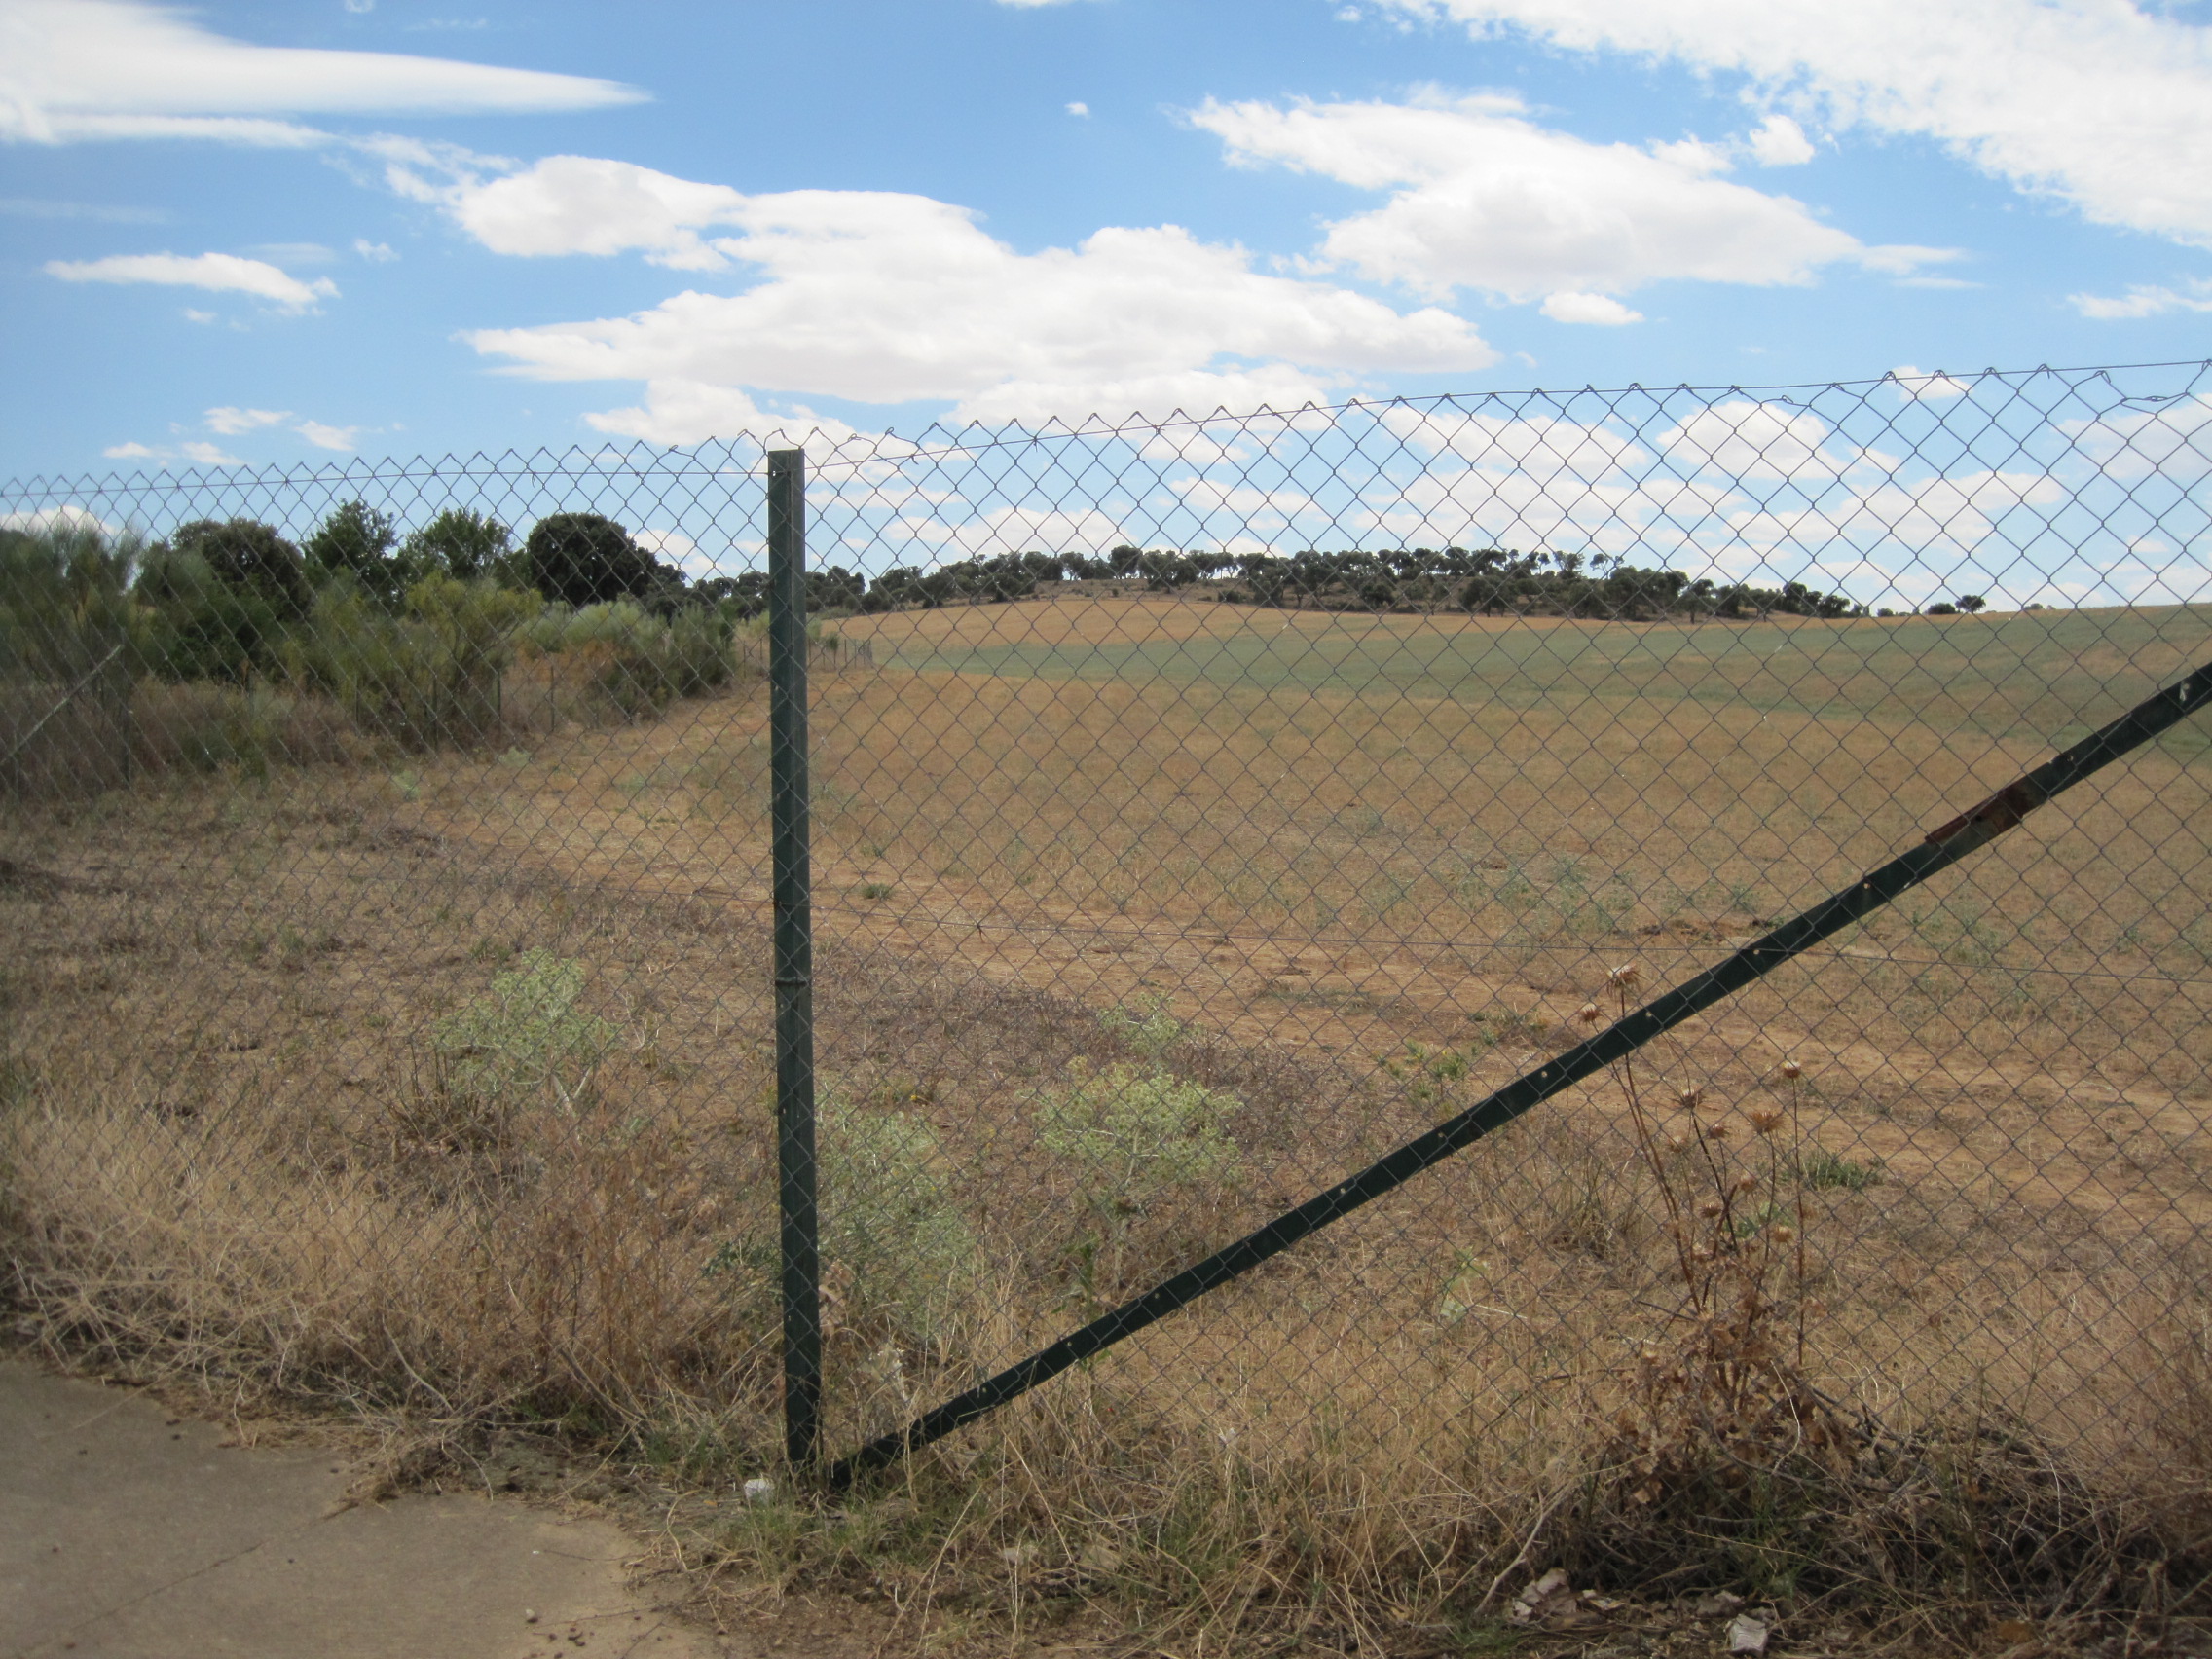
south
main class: Woodland
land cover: Broadleaved woodland
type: floodplain forest
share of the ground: > 75 %
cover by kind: broadleaved forest trees 80 %, herbaceous plants 20 %
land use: Forestry
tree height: > 5 m
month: July
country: ES
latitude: 42.0830
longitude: -5.5761
